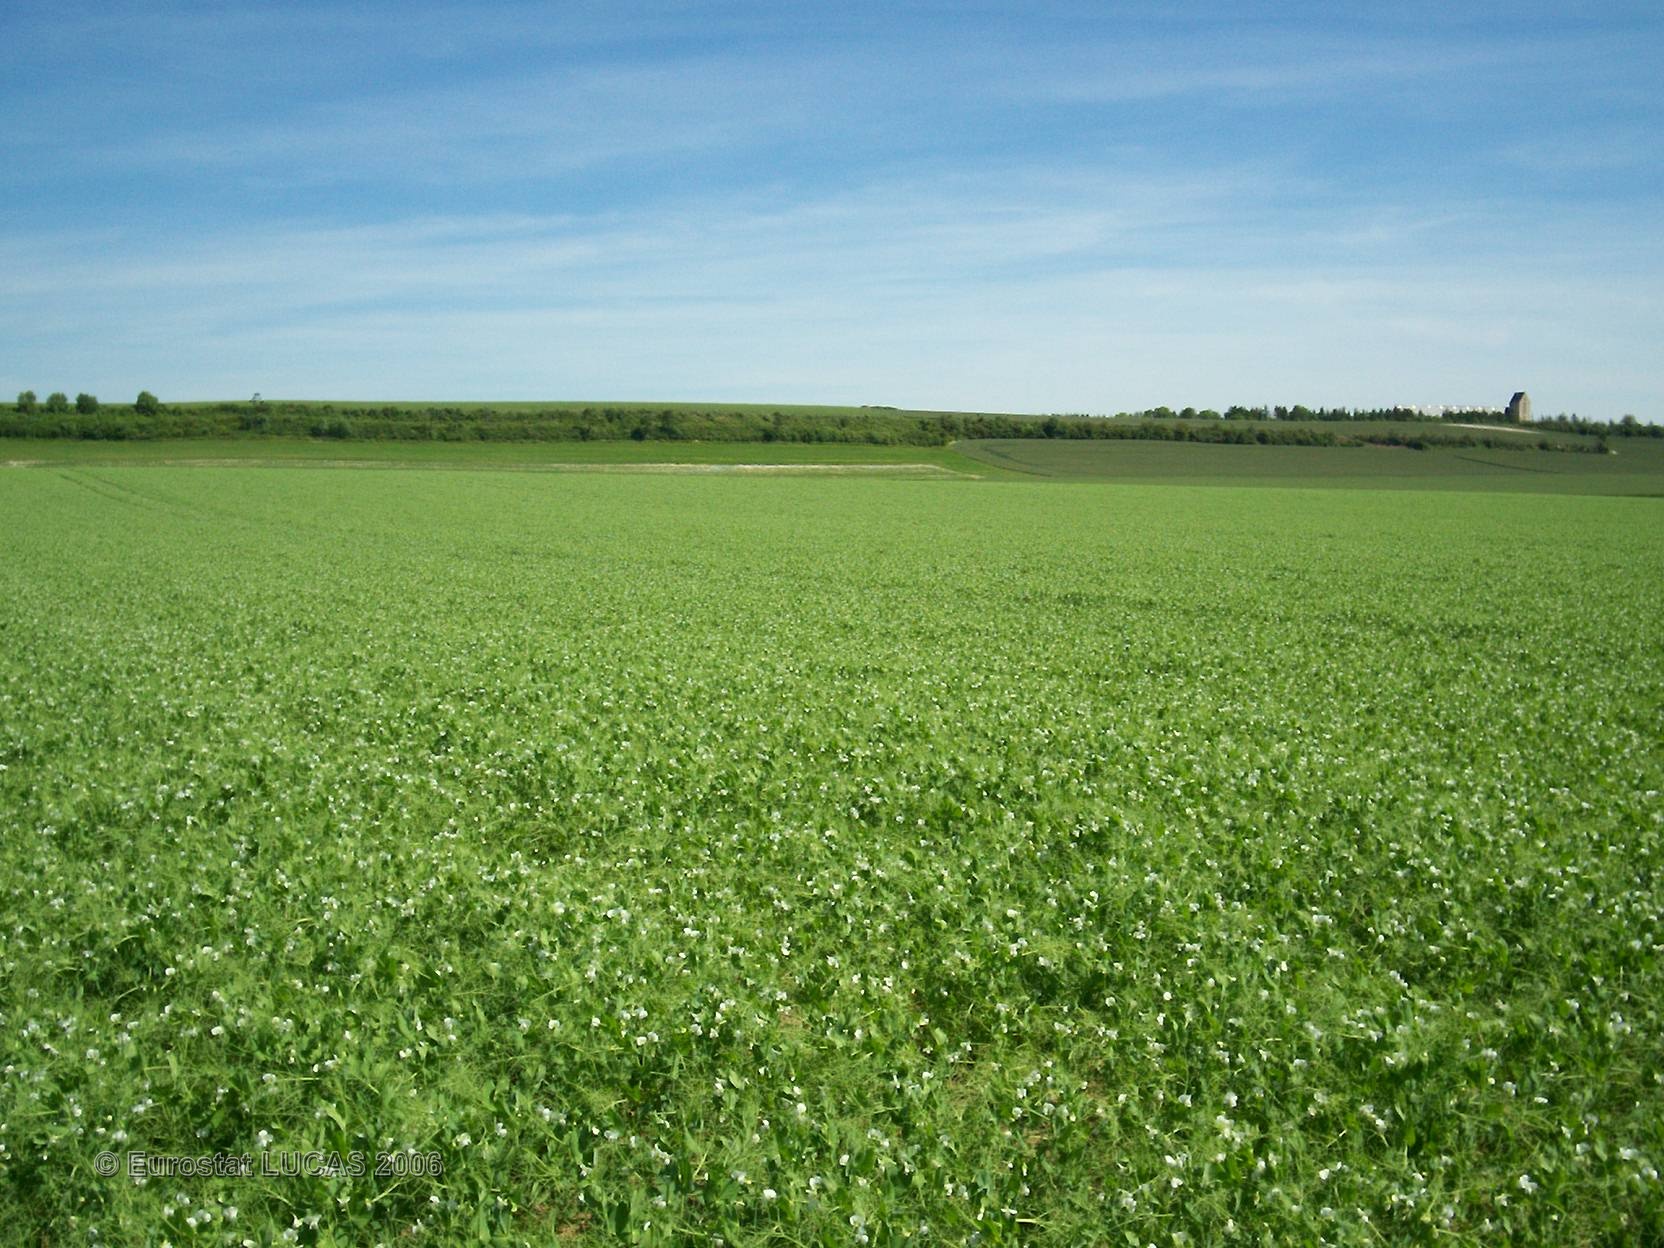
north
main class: Cropland
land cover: Barley
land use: Agriculture (excluding fallow land and kitchen gardens)
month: June
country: FR
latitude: 49.0736
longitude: 4.7818
